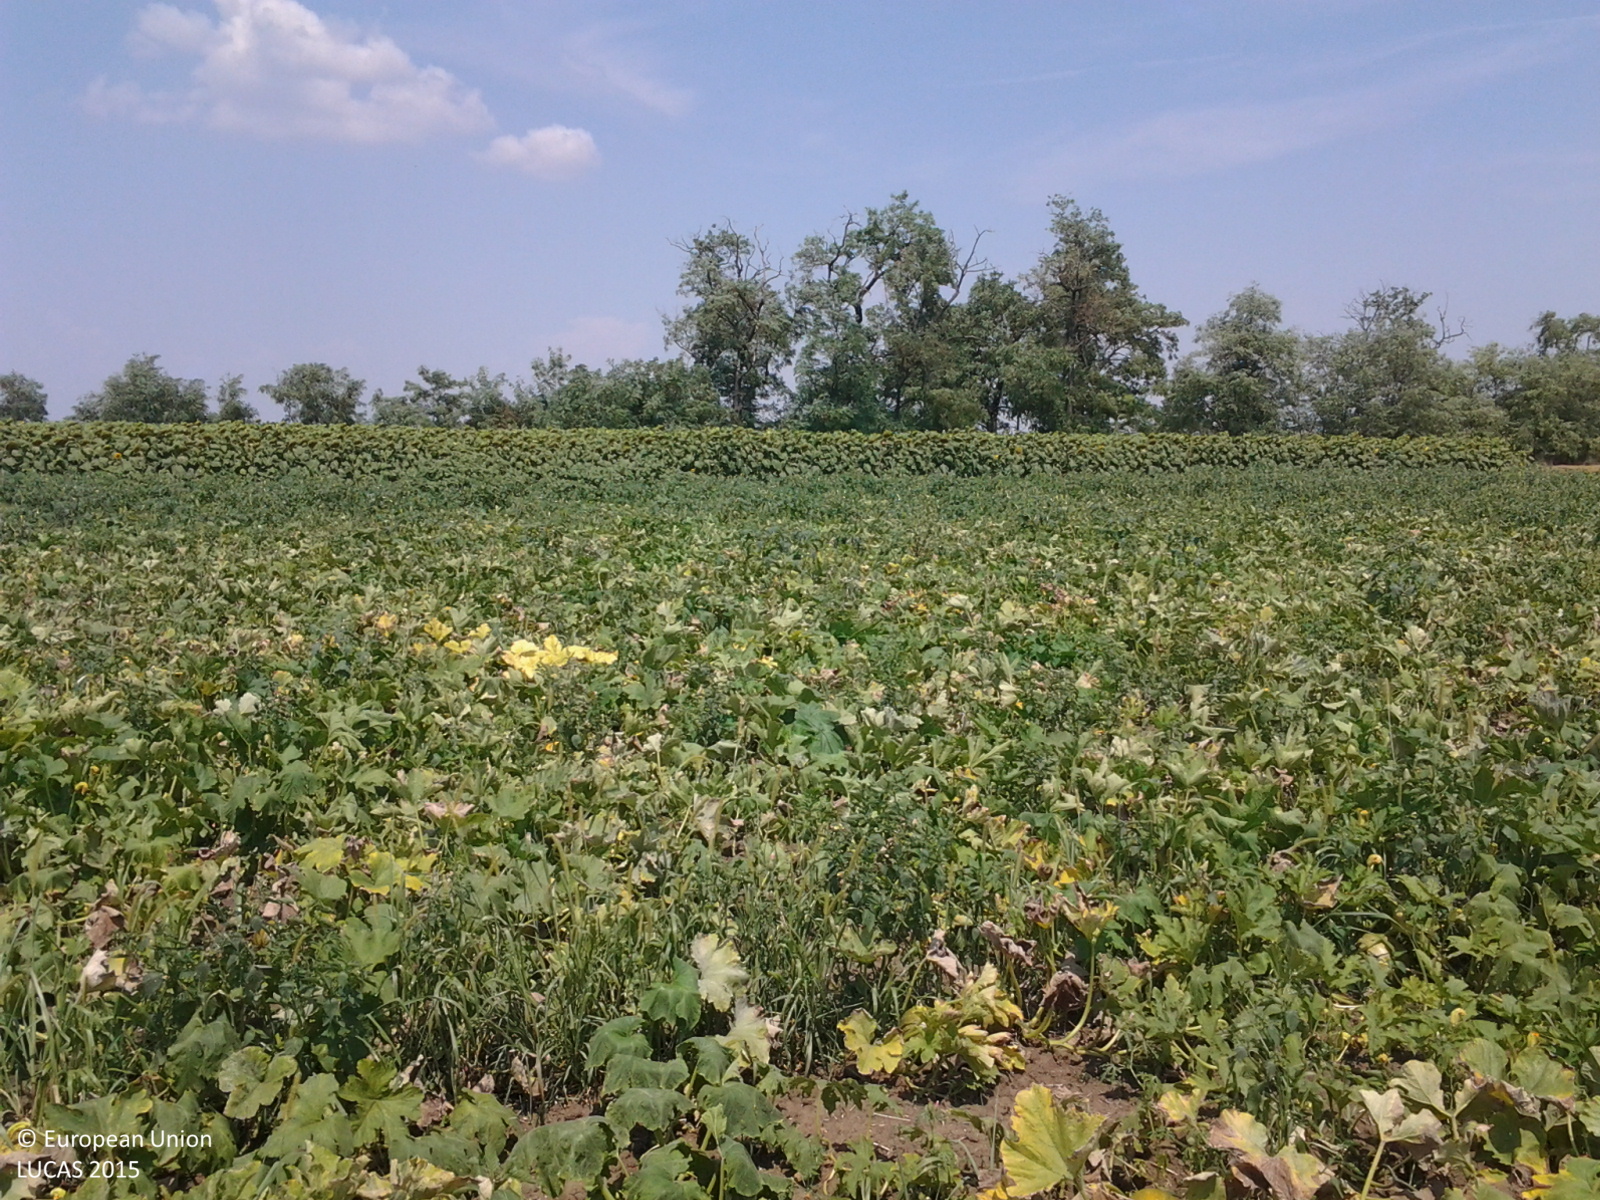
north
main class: Cropland
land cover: Other fresh vegetables
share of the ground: > 75 %
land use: Agriculture (excluding fallow land and kitchen gardens)
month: July
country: HU
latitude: 47.2531
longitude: 20.6420
